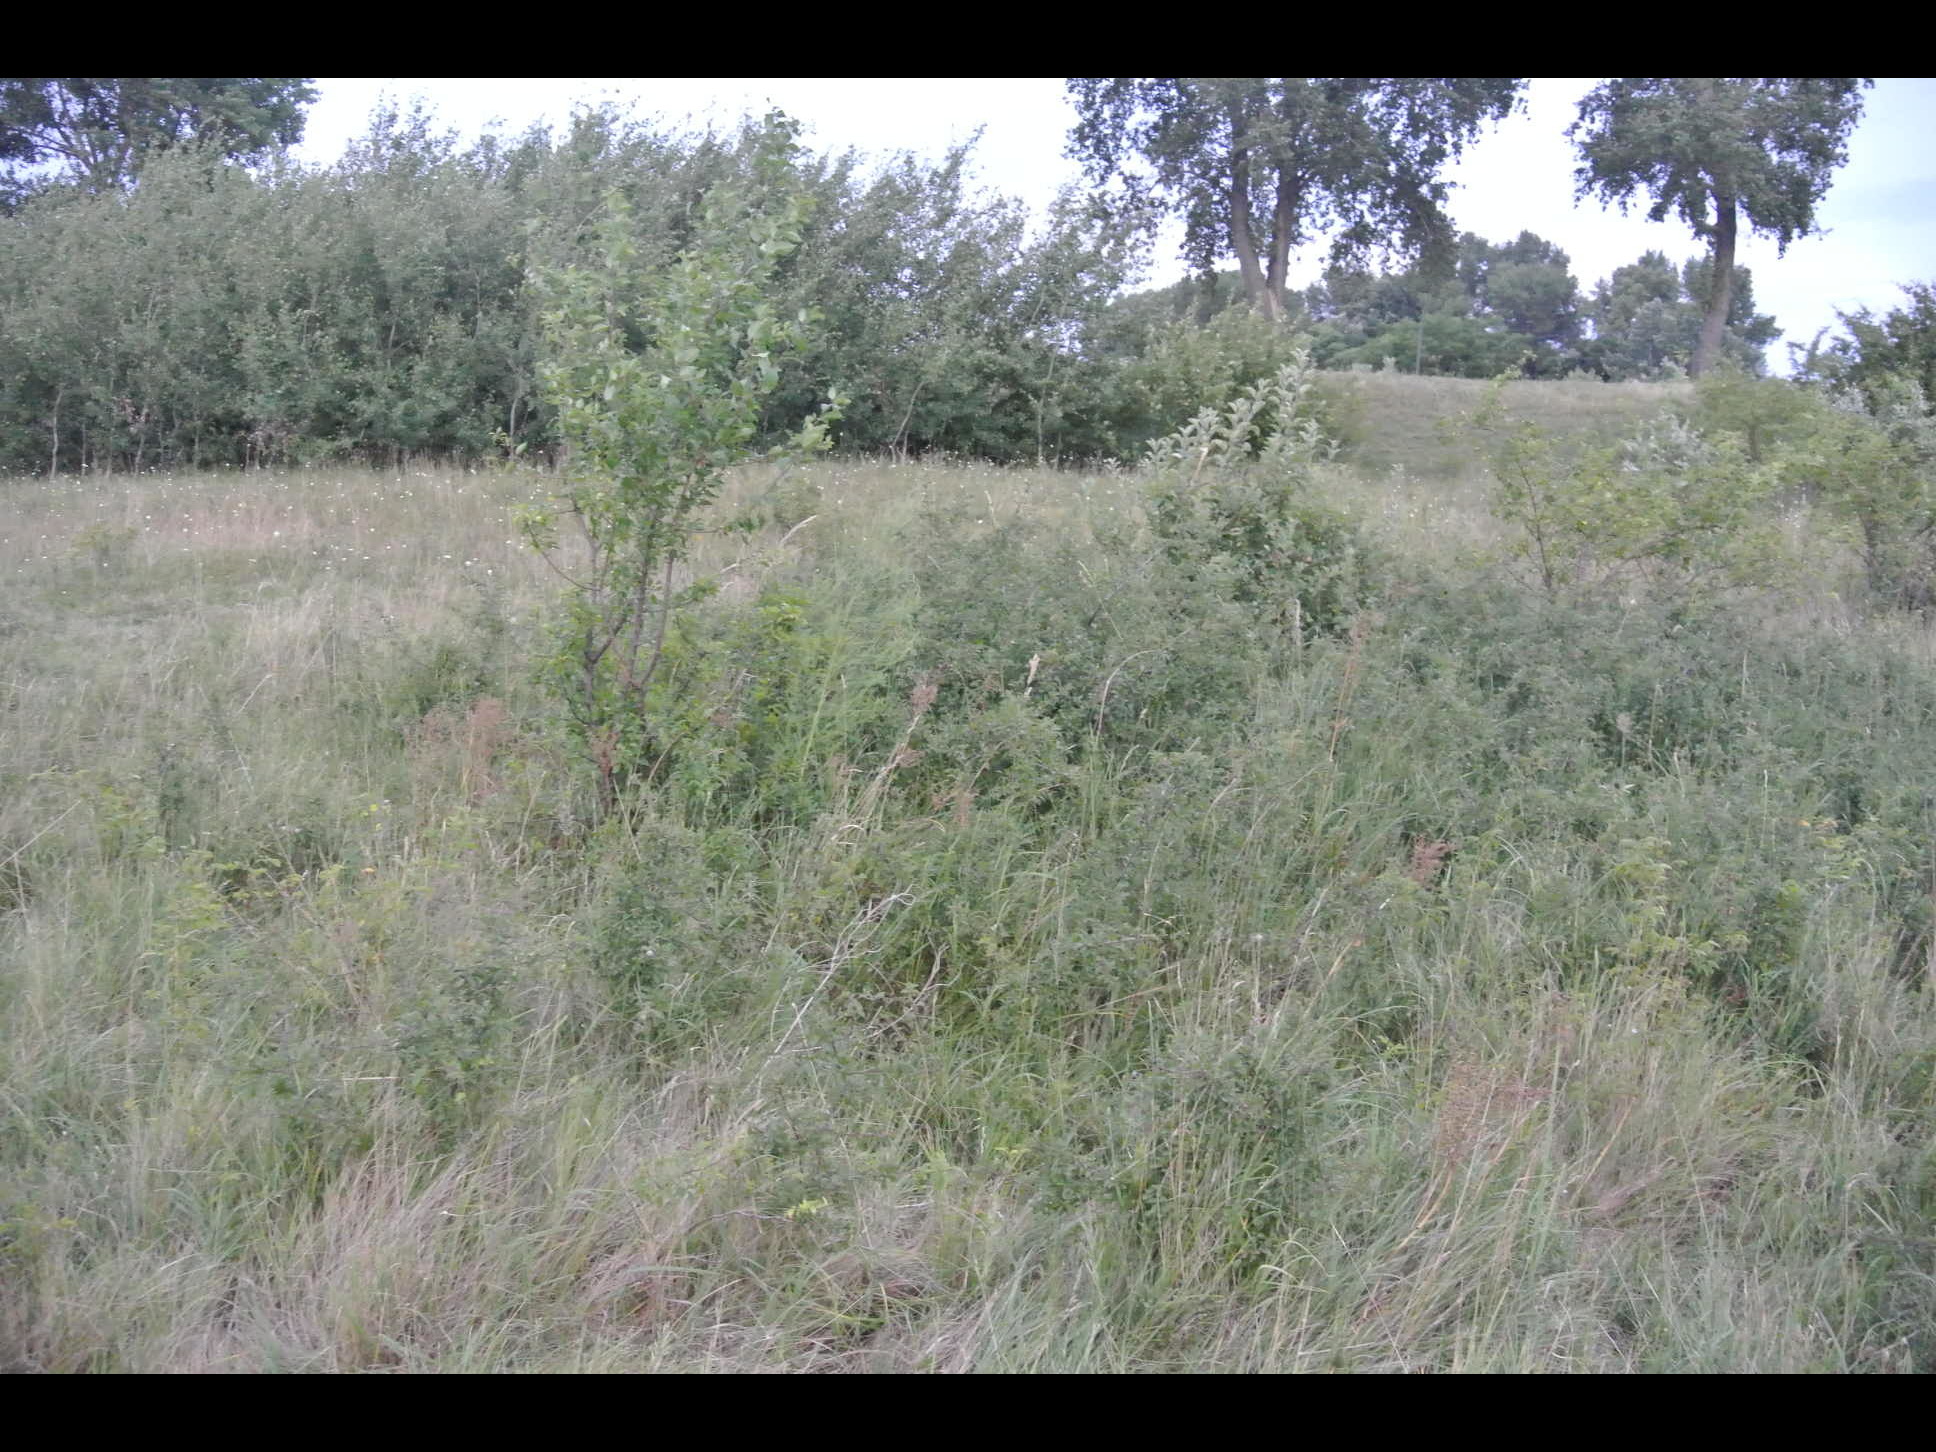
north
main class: Grassland
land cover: Grassland with sparse tree/shrub cover
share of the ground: > 75 %
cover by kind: herbaceous plants 90 %, broadleaved forest trees 5 %, shrubs 5 %
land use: Semi-natural and natural areas not in use
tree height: < 5 m
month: July
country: AT
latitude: 47.8326
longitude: 16.8058
